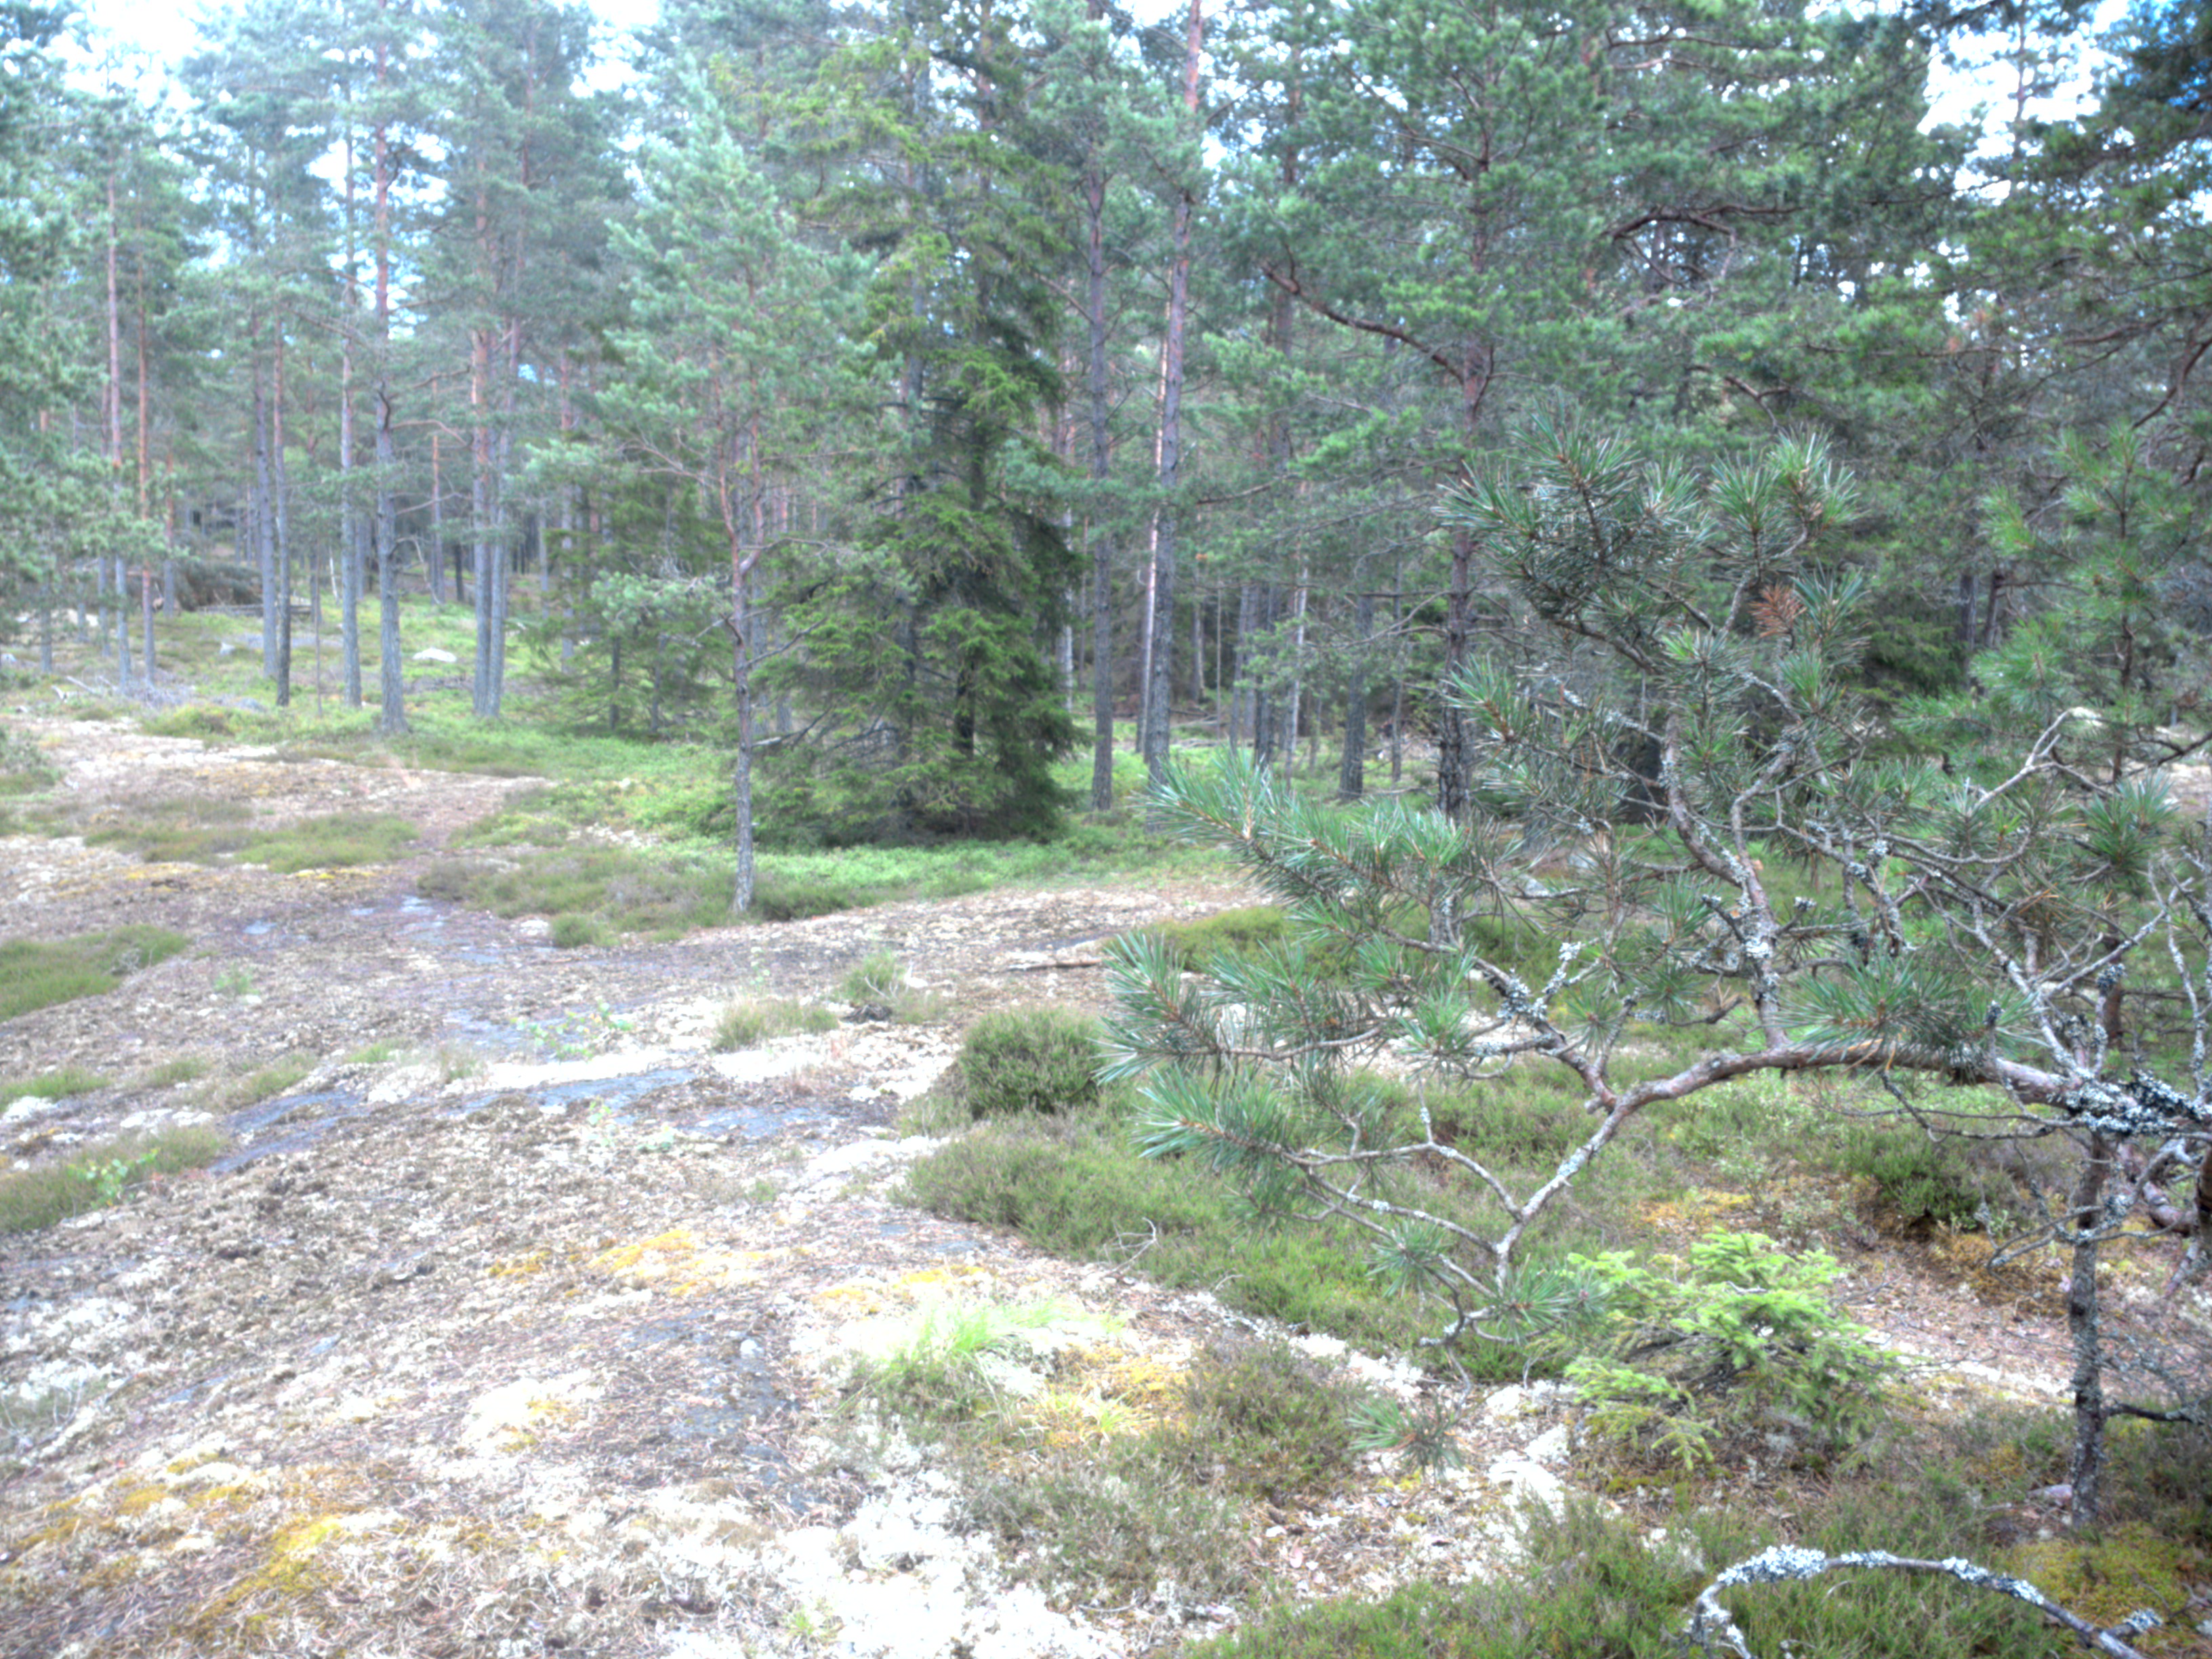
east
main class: Woodland
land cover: Pine dominated coniferous woodland
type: boreal forest
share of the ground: 25 - 50 %
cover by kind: shrubs 35 %, lichens and mosses 35 %, coniferous forest trees 30 %
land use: Forestry
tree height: > 5 m
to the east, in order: Pine dominated coniferous woodland
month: July
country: SE
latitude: 59.0917
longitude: 18.1862
